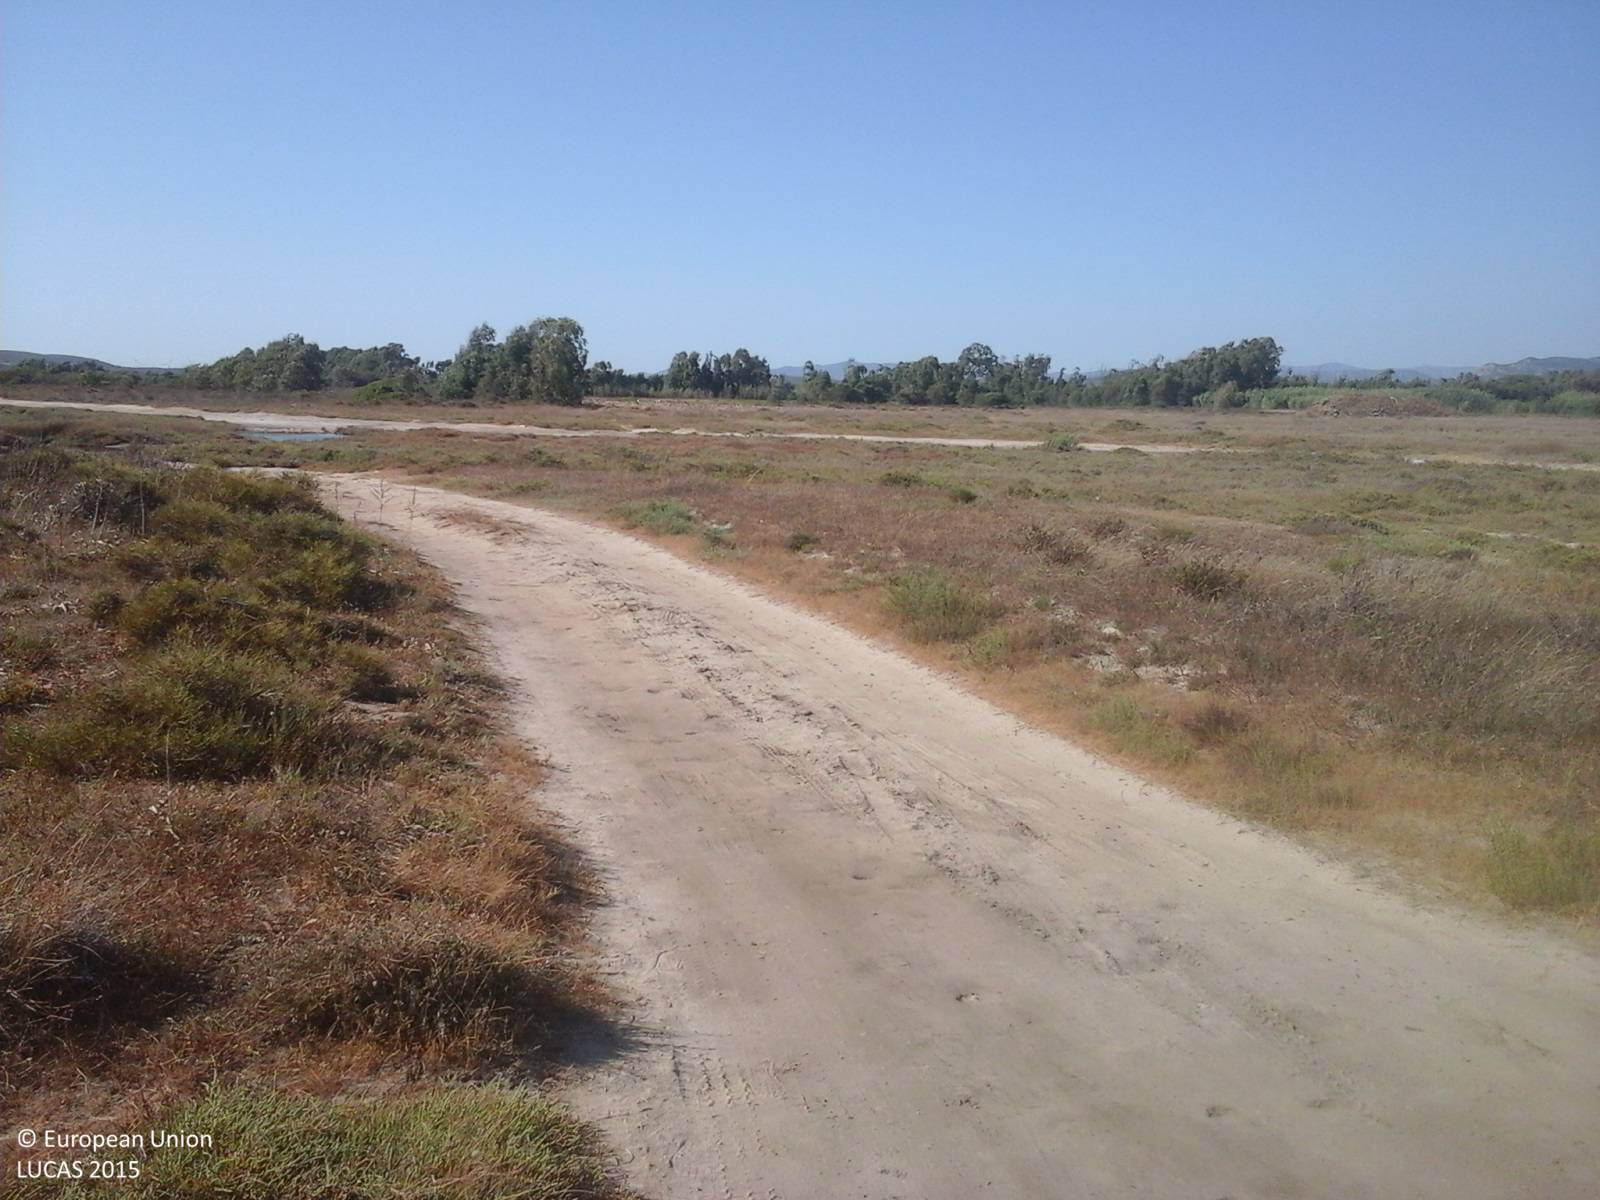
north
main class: Grassland
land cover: Grassland without tree/shrub cover
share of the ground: > 75 %
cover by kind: herbaceous plants 90 %, unconsolidated bare surface 10 %
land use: Semi-natural and natural areas not in use
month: July
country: IT
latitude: 39.1141
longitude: 8.4714
